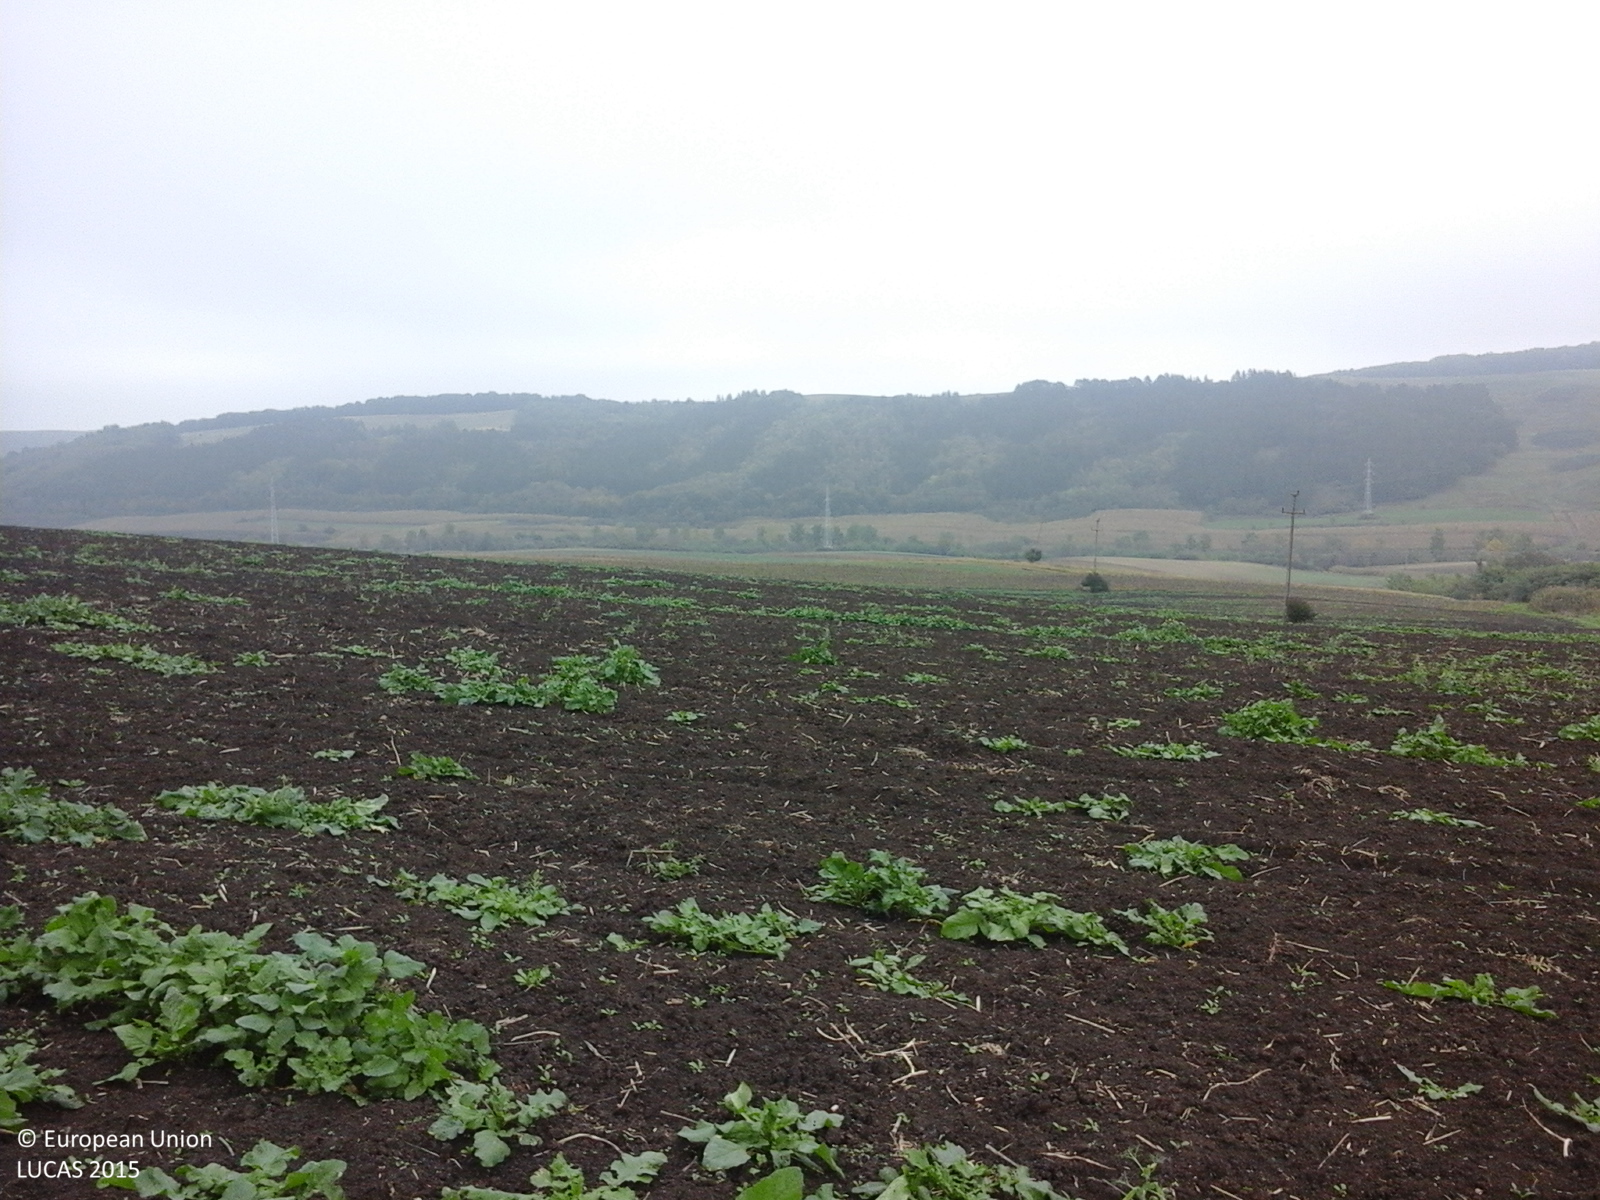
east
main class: Cropland
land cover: Rape and turnip rape
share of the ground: 50 - 75 %
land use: Agriculture (excluding fallow land and kitchen gardens)
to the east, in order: Rape and turnip rape; Sunflower
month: October
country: RO
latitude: 46.4006
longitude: 24.2186
